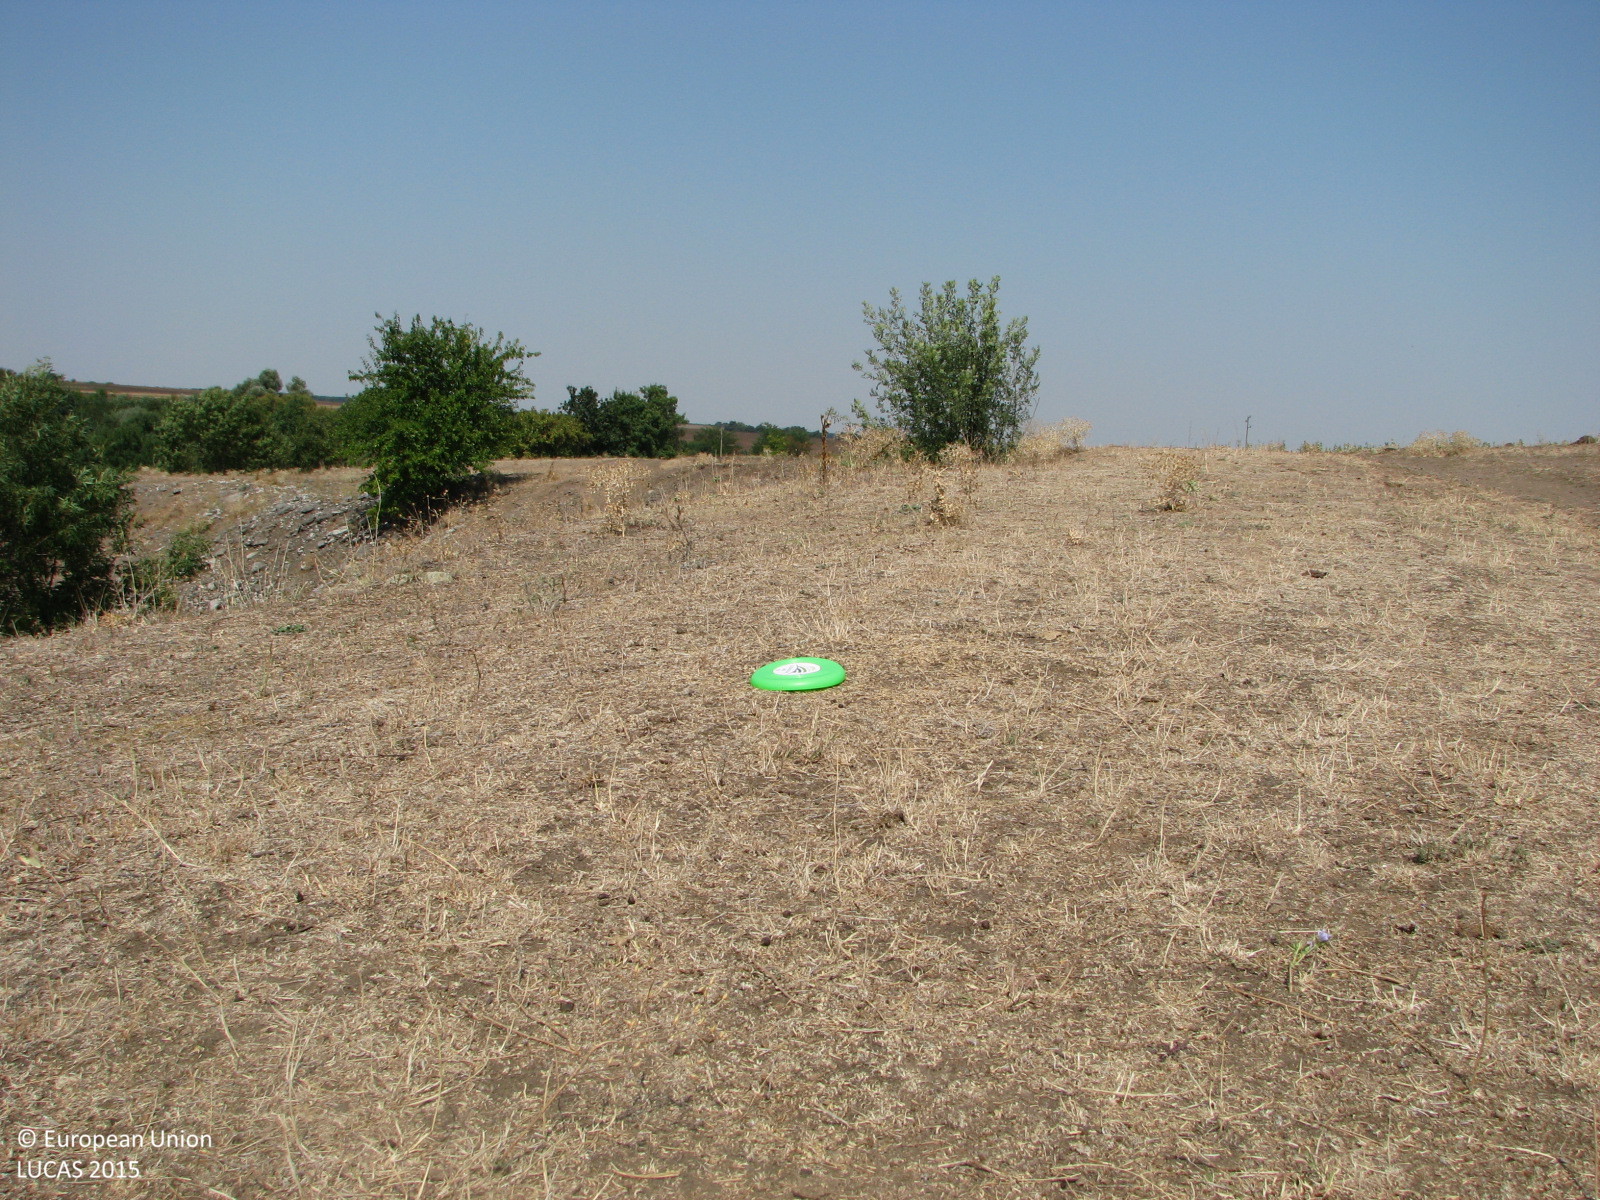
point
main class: Grassland
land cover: Grassland without tree/shrub cover
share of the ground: > 75 %
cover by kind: herbaceous plants 90 %, unconsolidated bare surface 10 %
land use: Agriculture (excluding fallow land and kitchen gardens)
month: September
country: BG
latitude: 42.3805
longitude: 26.7979
